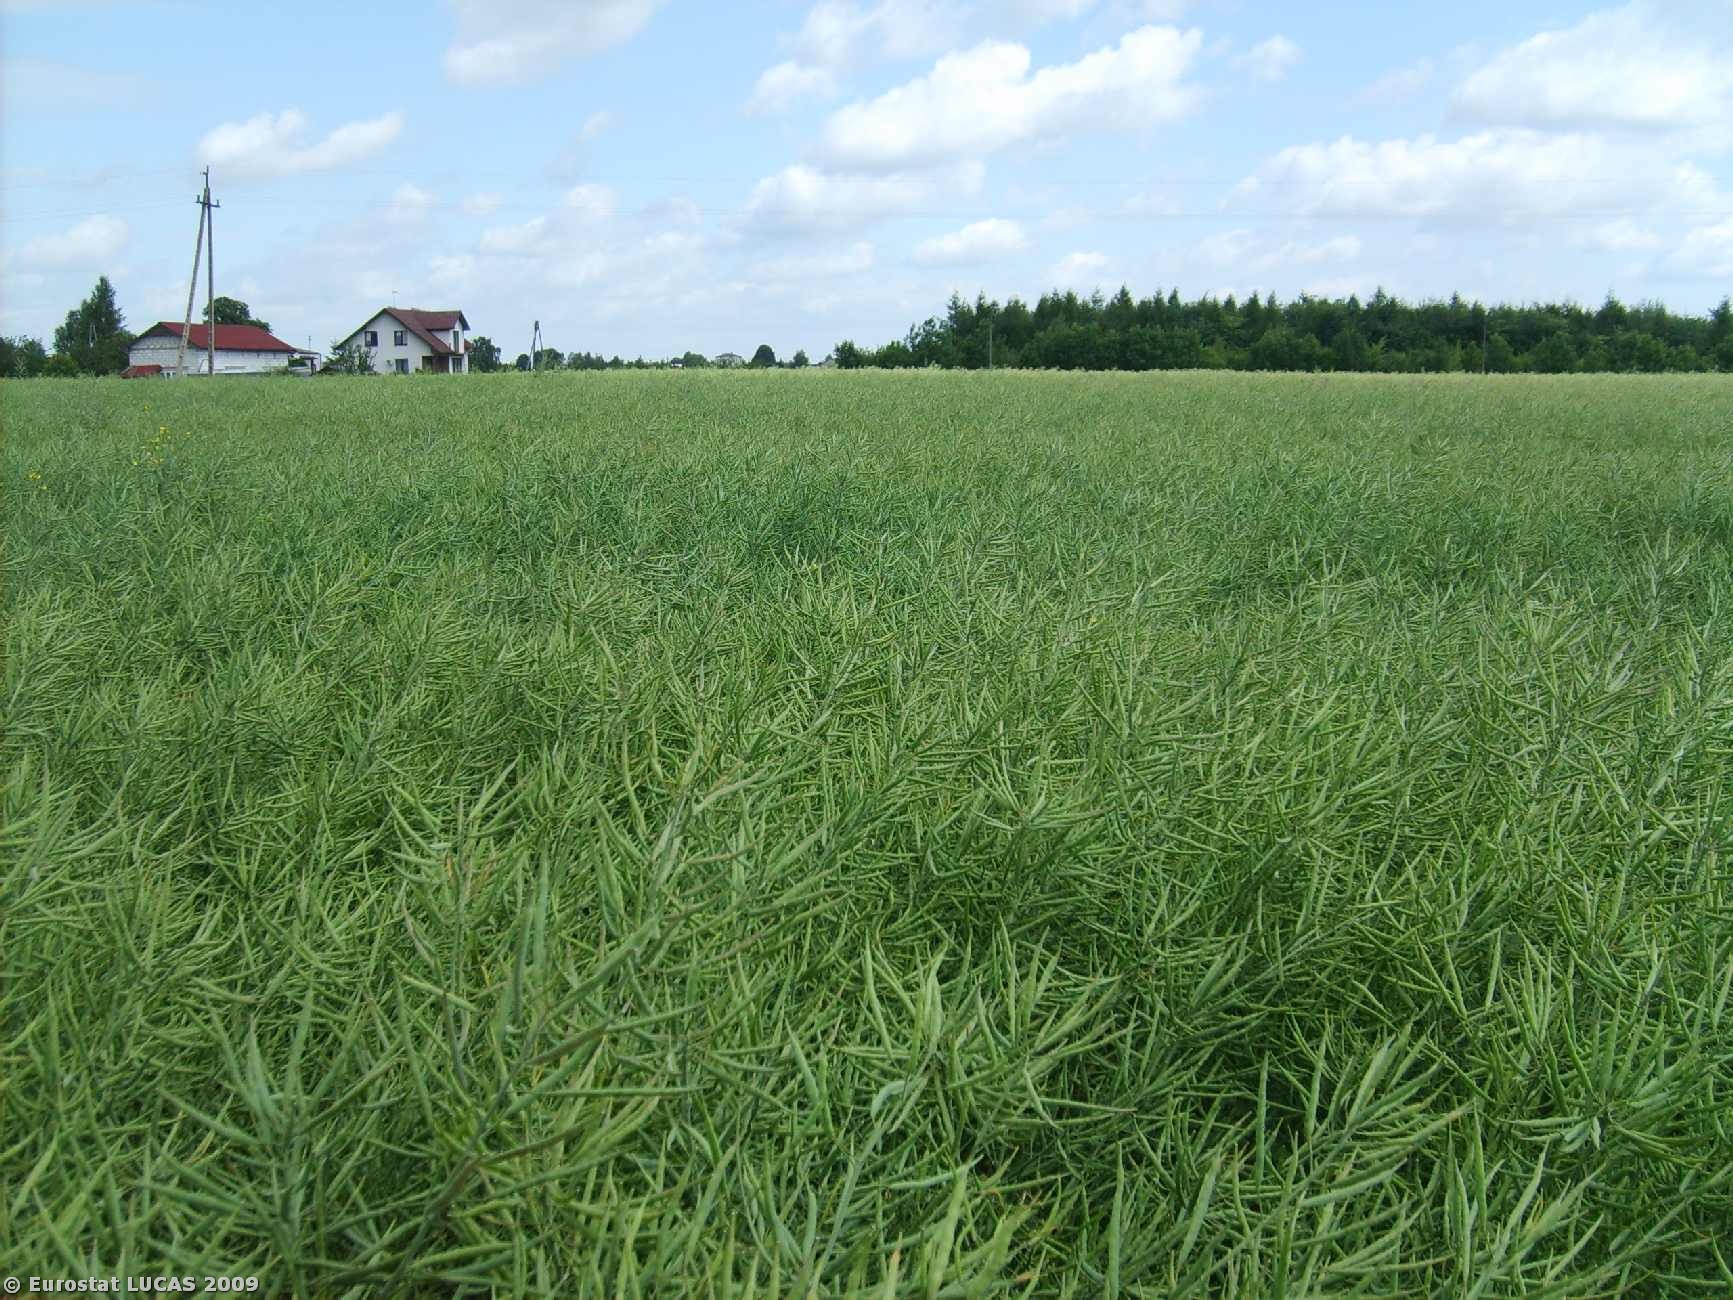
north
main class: Cropland
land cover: Rape and turnip rape
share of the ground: > 75 %
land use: Agriculture (excluding fallow land and kitchen gardens)
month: June
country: PL
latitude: 51.1596
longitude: 22.4048
